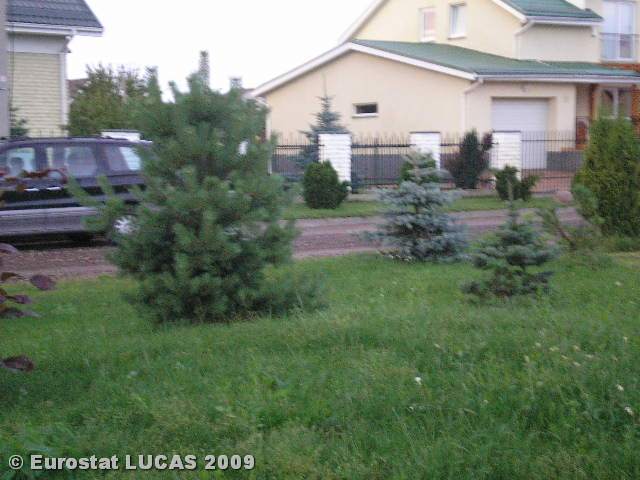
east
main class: Grassland
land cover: Grassland with sparse tree/shrub cover
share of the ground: > 75 %
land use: Residential
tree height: > 5 m
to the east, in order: Grassland with sparse tree/shrub cover; Artificial constructions in urban areas
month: July
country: LT
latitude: 54.7800
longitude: 25.3441
